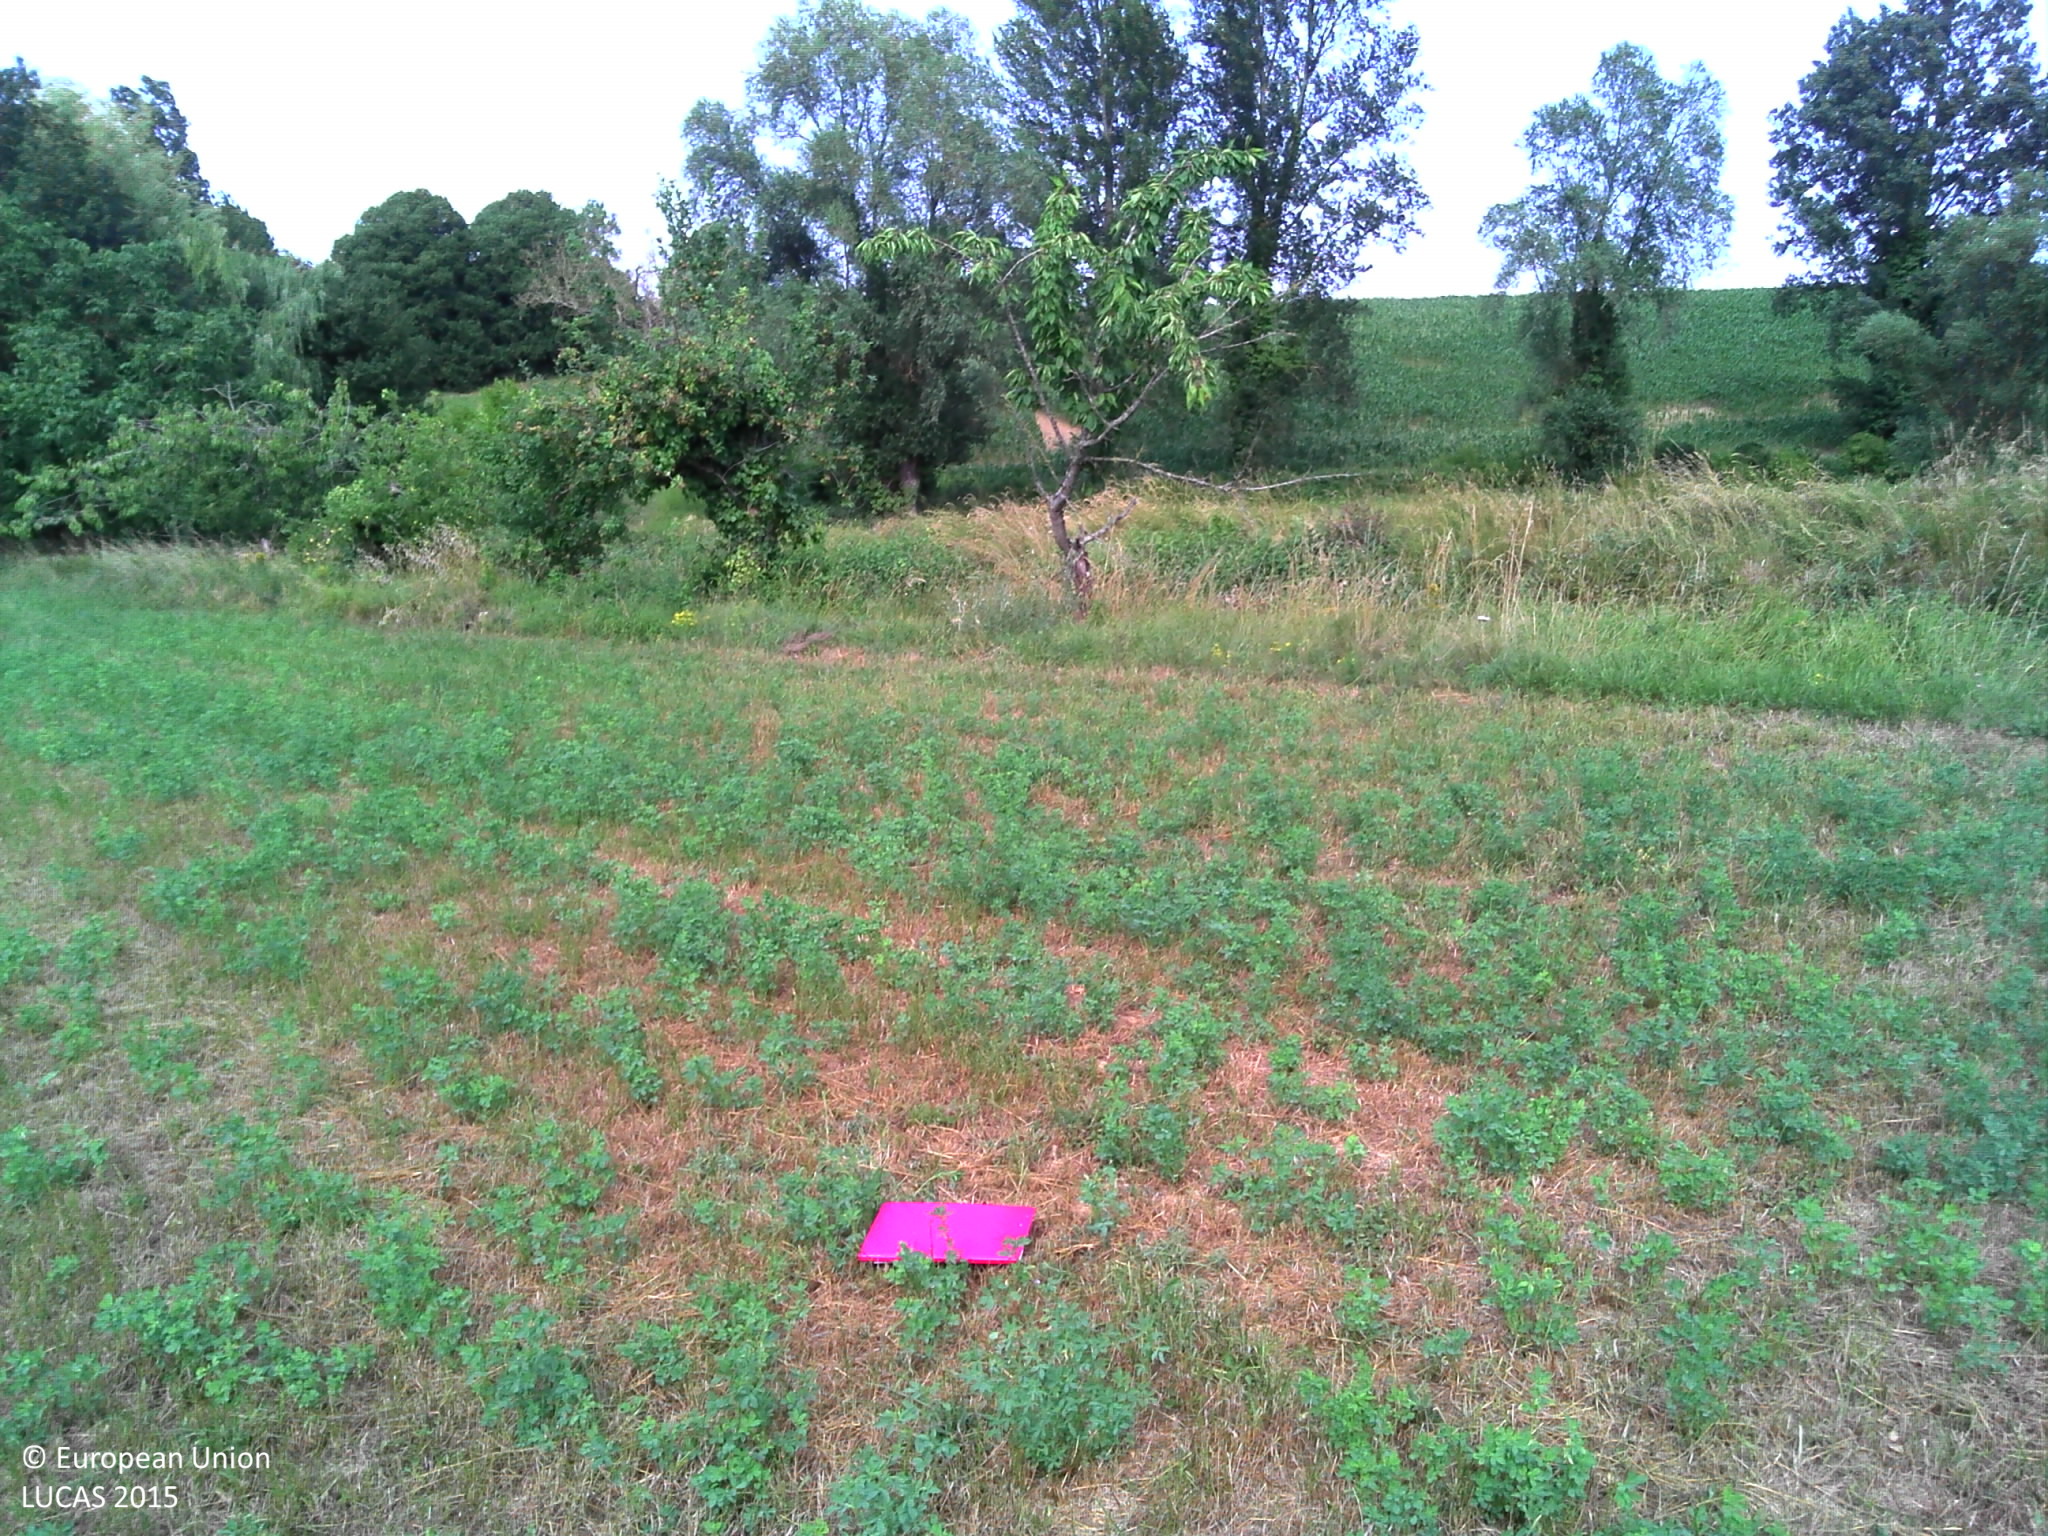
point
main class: Cropland
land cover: Lucerne
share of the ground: > 75 %
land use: Agriculture (excluding fallow land and kitchen gardens)
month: July
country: FR
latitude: 43.6134
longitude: 0.9922
